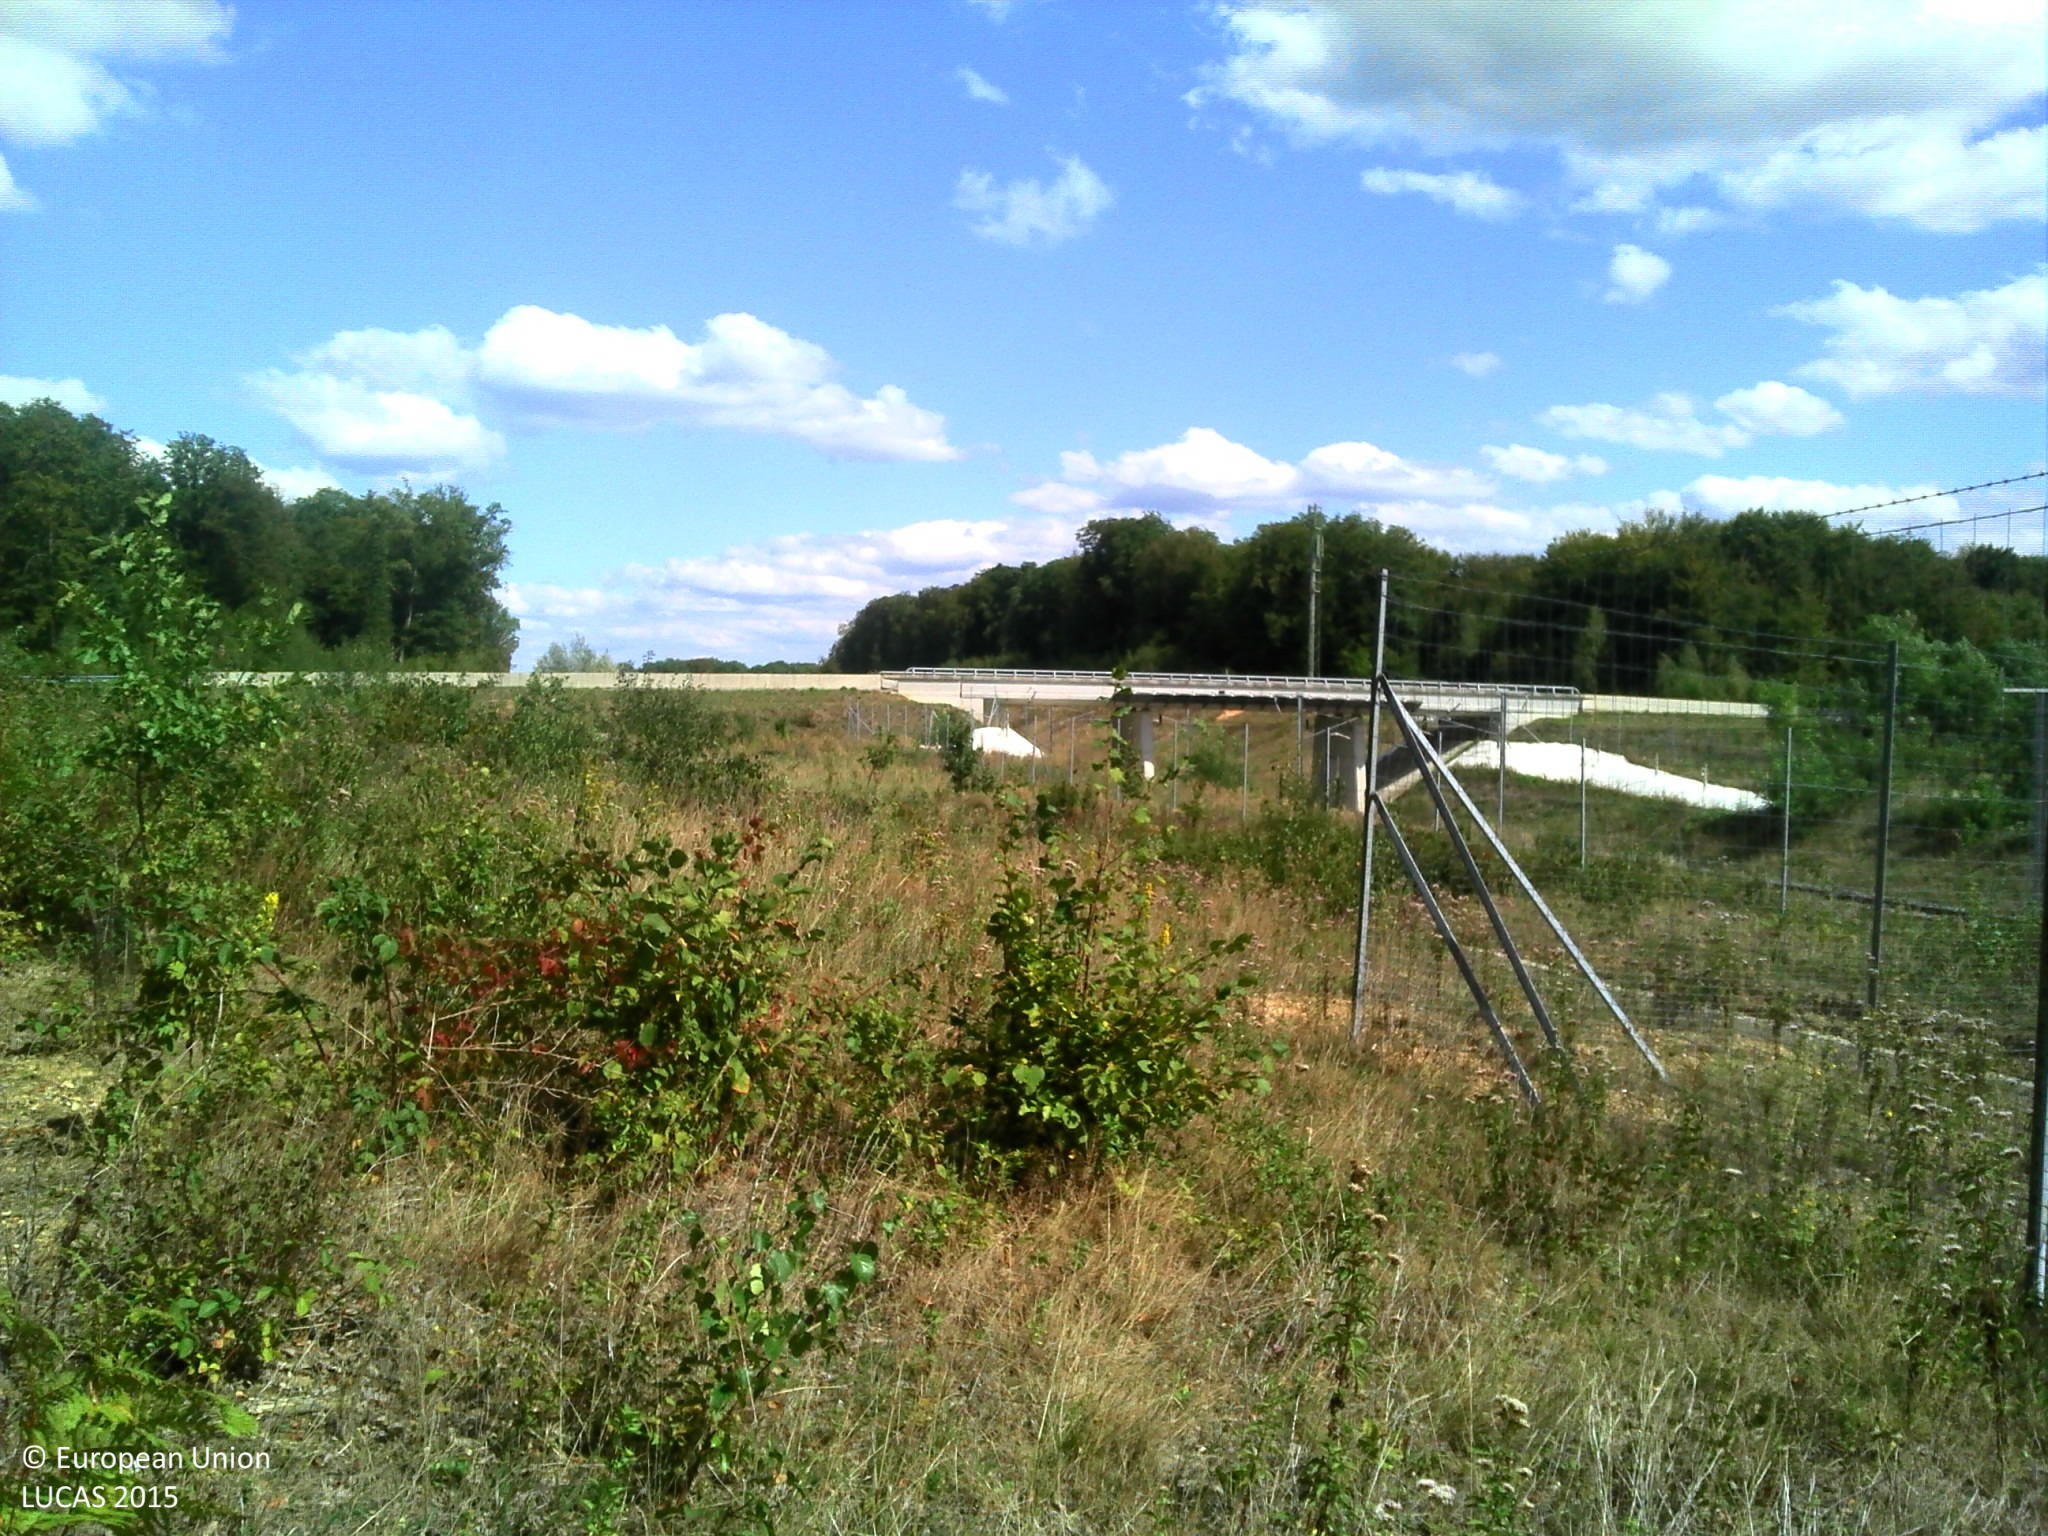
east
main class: Shrubland
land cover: Shrubland with sparse tree cover
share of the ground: > 75 %
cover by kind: herbaceous plants 60 %, shrubs 20 %, unconsolidated bare surface 15 %, broadleaved forest trees 5 %
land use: Semi-natural and natural areas not in use
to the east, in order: Shrubland with sparse tree cover; Ditches and canals; Fences; Spontaneously vegetated surfaces; Paved roads, cycling and walking lanes; Artificial constructions; Electric lines; Railways; Electric lines; Artificial constructions; Fences; Grassland without tree/shrub cover
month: September
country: FR
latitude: 47.4966
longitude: 6.3511
